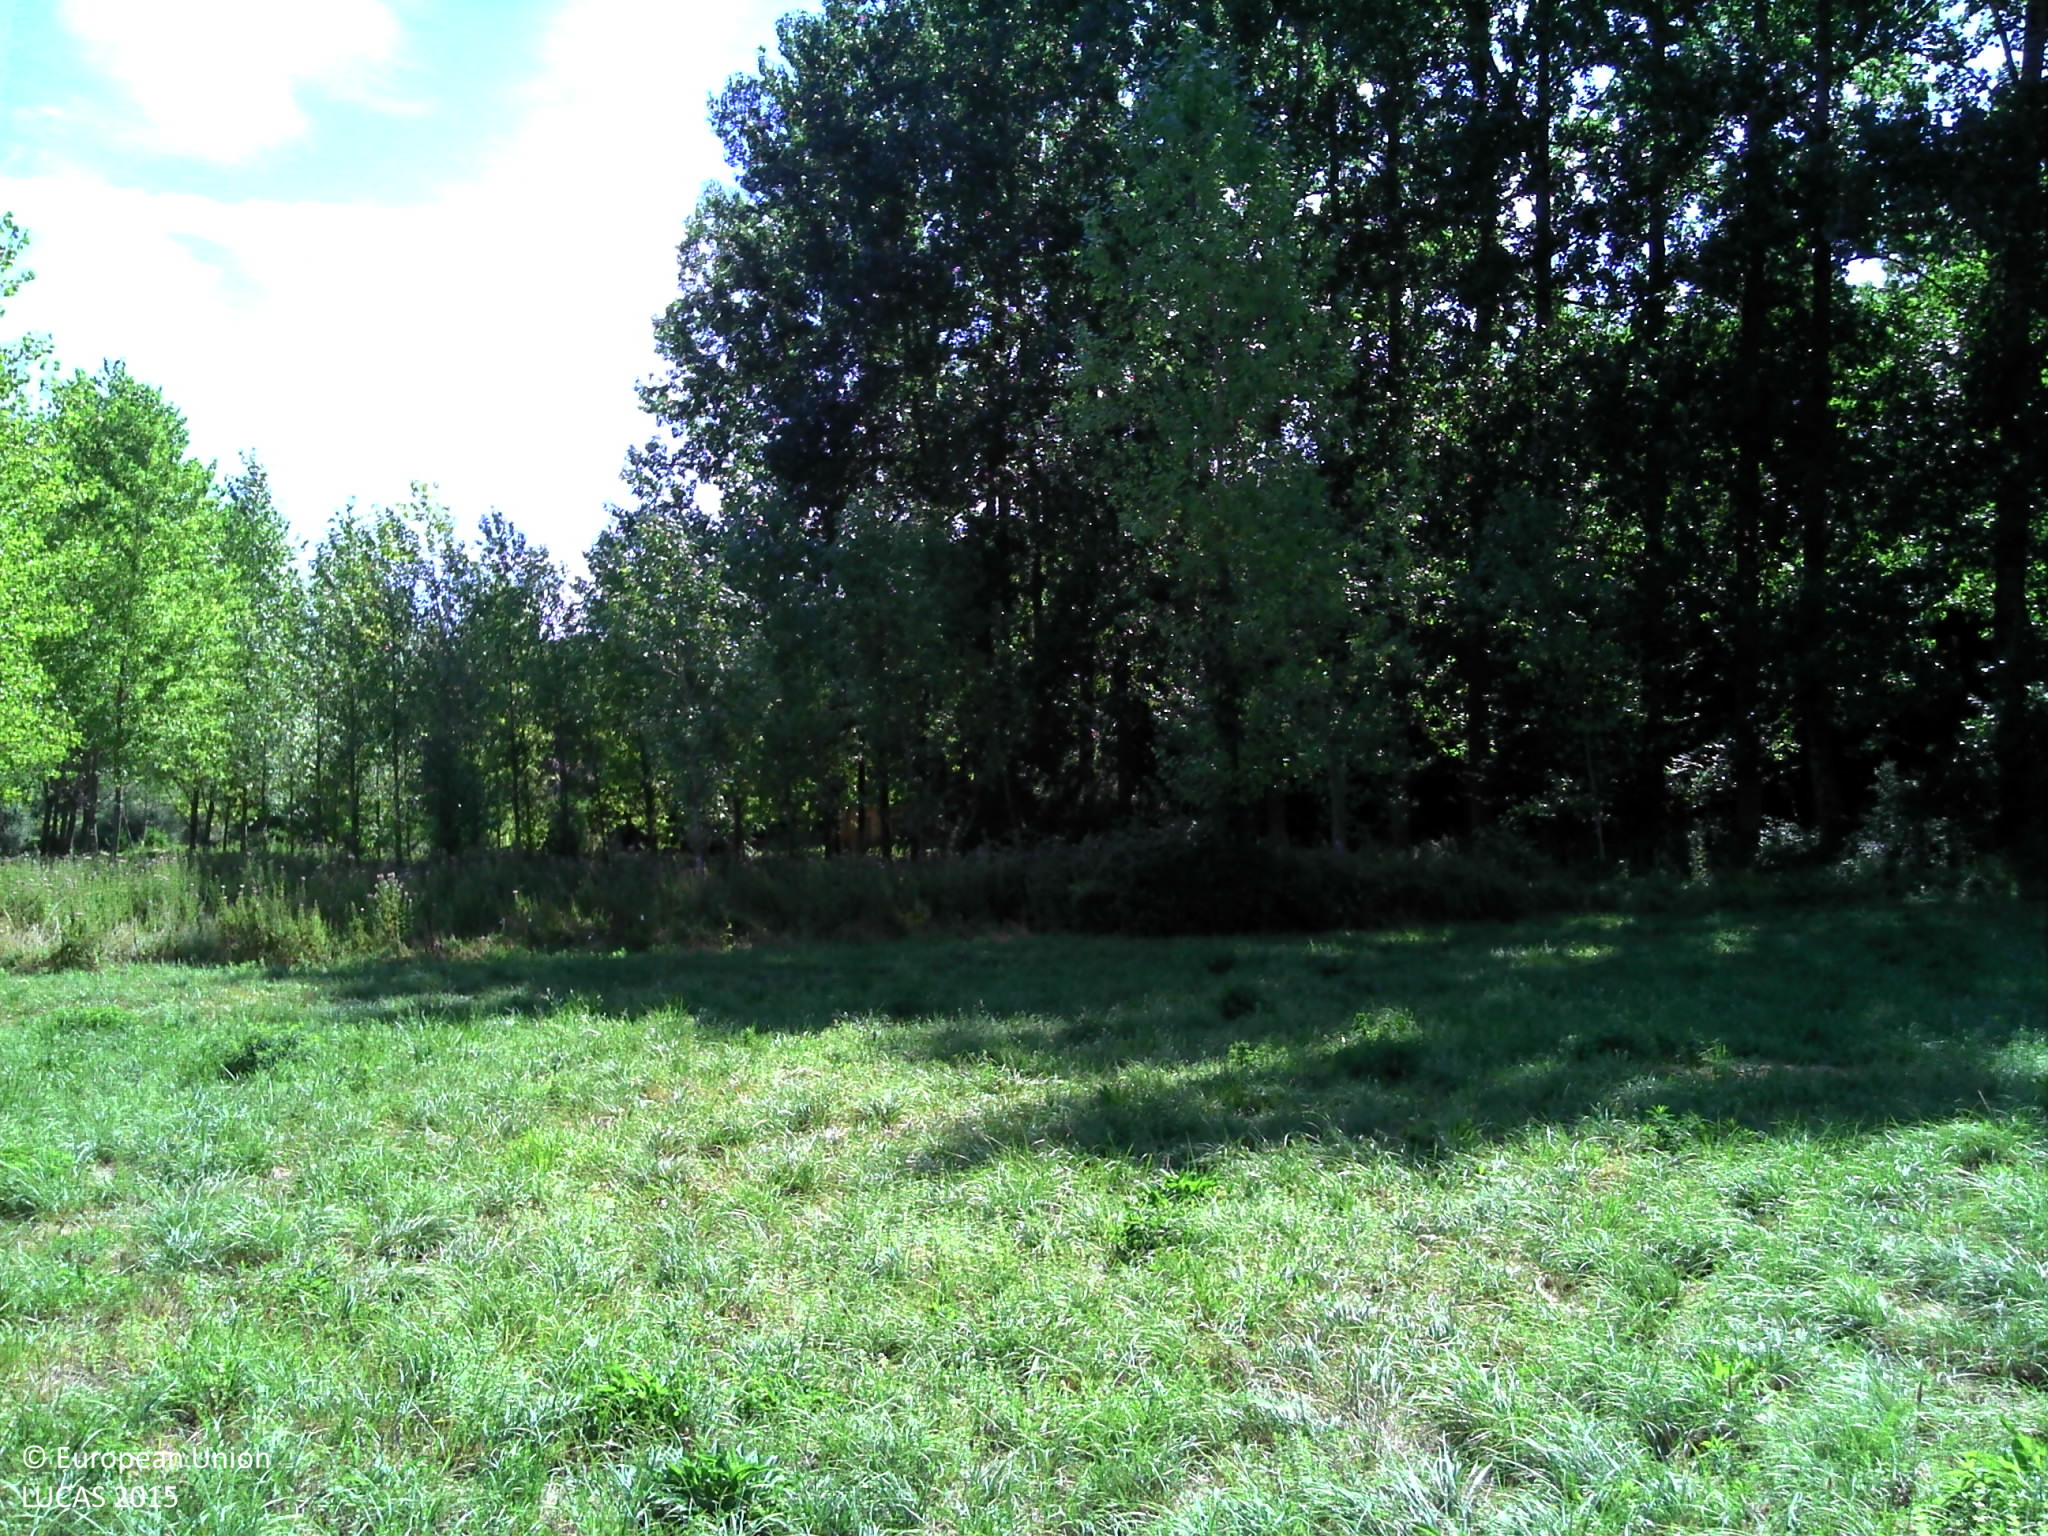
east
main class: Grassland
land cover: Grassland without tree/shrub cover
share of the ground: > 75 %
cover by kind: herbaceous plants 100 %
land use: Agriculture (excluding fallow land and kitchen gardens)
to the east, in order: Grassland without tree/shrub cover; Broadleaved woodland; Tracks; Grass margins; Dry stone walls; Broadleaved woodland; Artificial constructions in urban areas; Broadleaved woodland
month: July
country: FR
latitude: 44.9717
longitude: 1.1818
